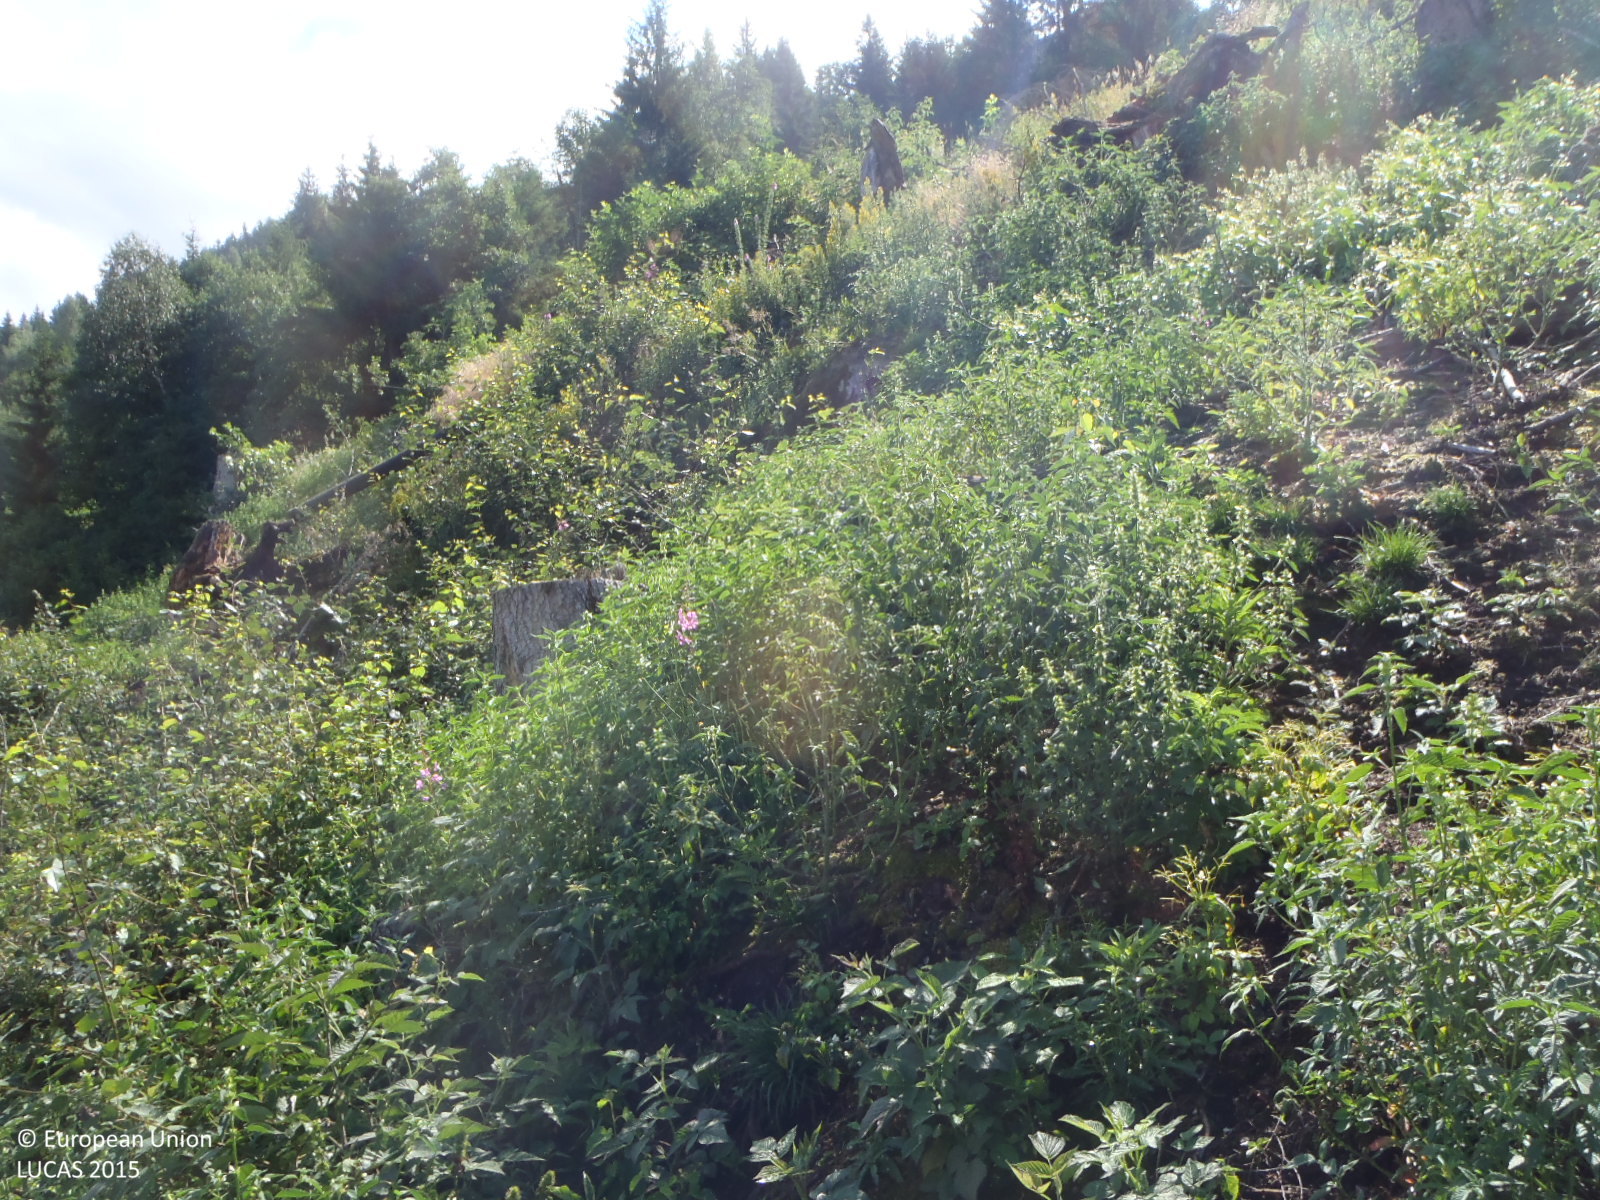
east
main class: Shrubland
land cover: Shrubland with sparse tree cover
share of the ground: > 75 %
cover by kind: shrubs 95 %, broadleaved forest trees 5 %
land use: Forestry
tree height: < 5 m
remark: Clear cut
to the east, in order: Shrubland with sparse tree cover; Dry stone walls; Grassland without tree/shrub cover; Broadleaved woodland; Spruce dominated mixed woodland; Spontaneously vegetated surfaces; Paved roads, cycling and walking lanes; Broadleaved woodland; Paved roads, cycling and walking lanes; Grassland without tree/shrub cover; Artificial constructions in urban areas; Grassland without tree/shrub cover
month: July
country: AT
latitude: 47.2347
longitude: 11.9137
